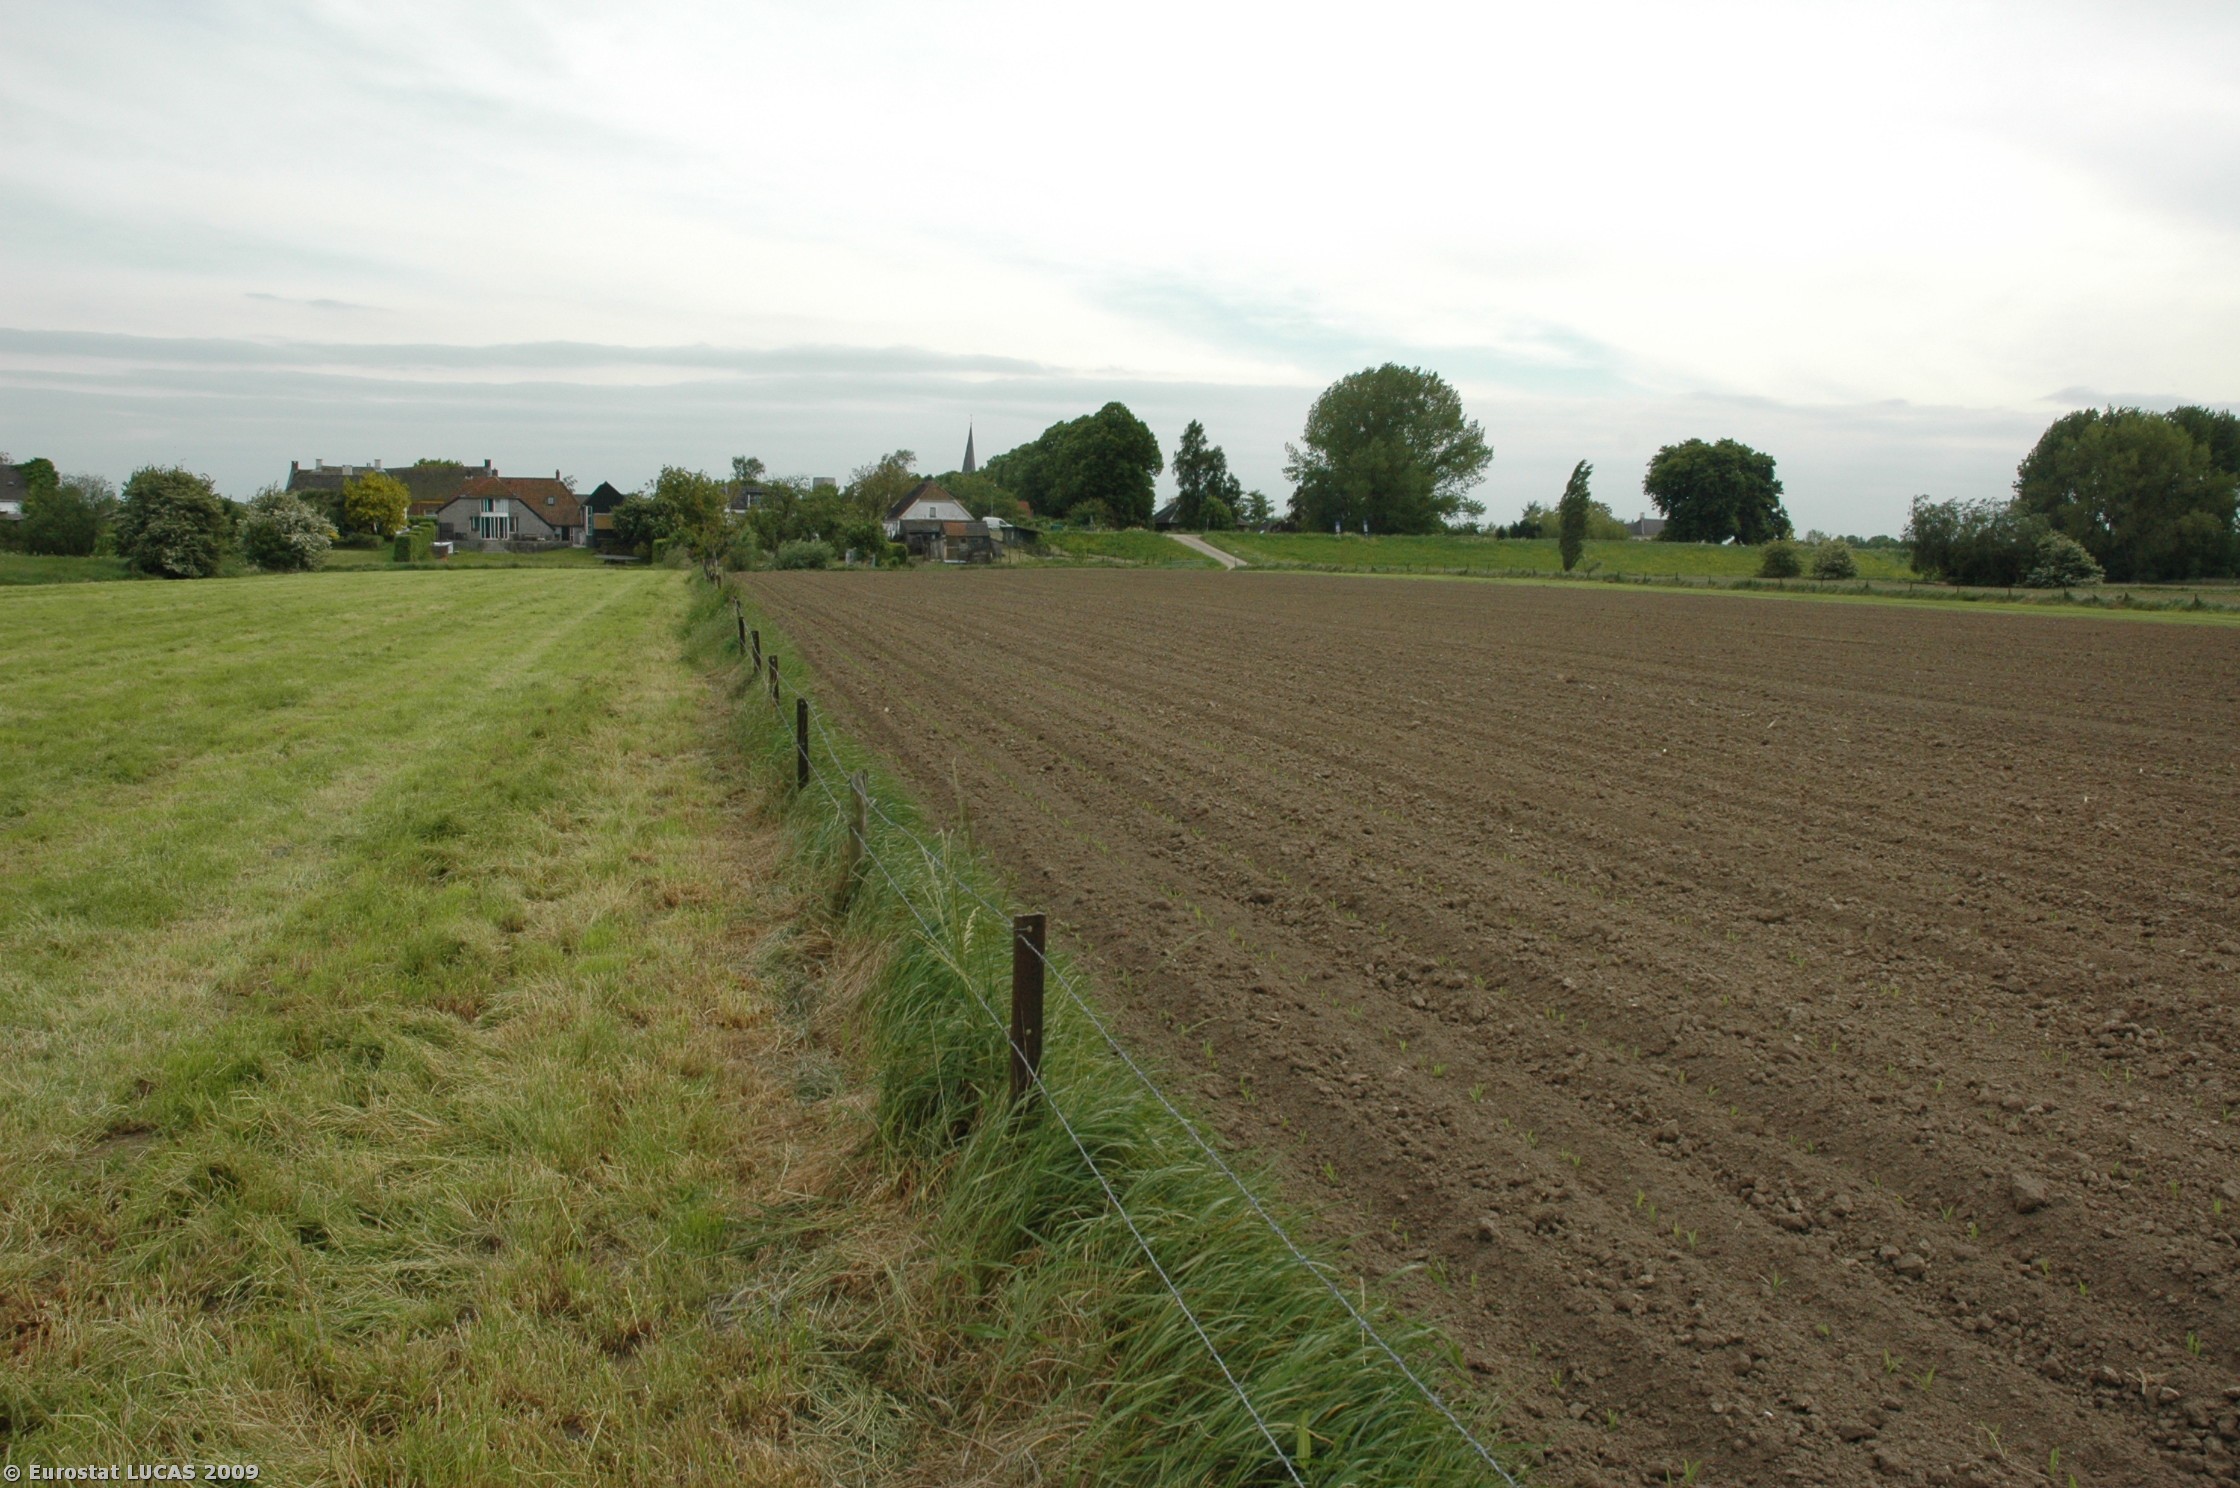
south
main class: Grassland
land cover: Grassland without tree/shrub cover
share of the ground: > 75 %
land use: Agriculture (excluding fallow land and kitchen gardens)
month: May
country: NL
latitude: 51.9626
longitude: 5.3554
